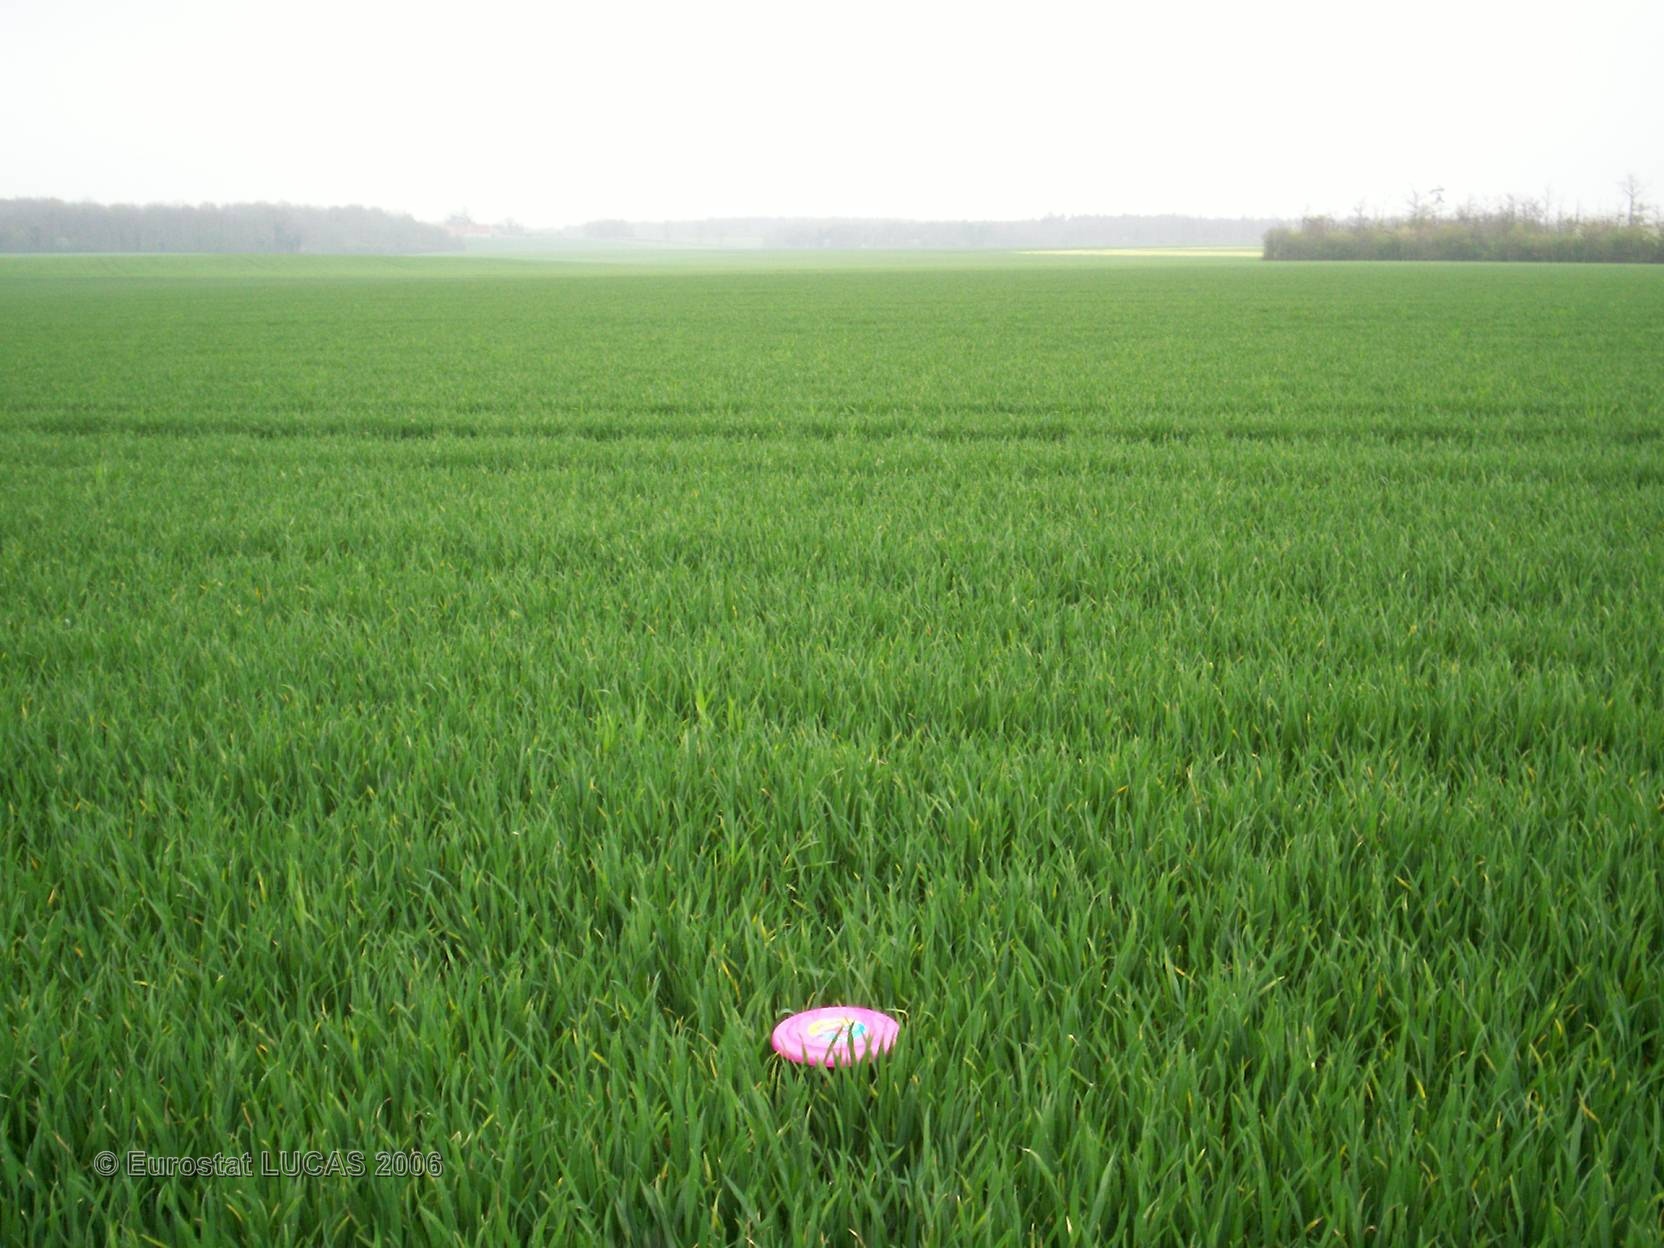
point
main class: Cropland
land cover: Common wheat
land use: Agriculture (excluding fallow land and kitchen gardens)
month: April
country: FR
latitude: 47.8162
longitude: 4.5094
